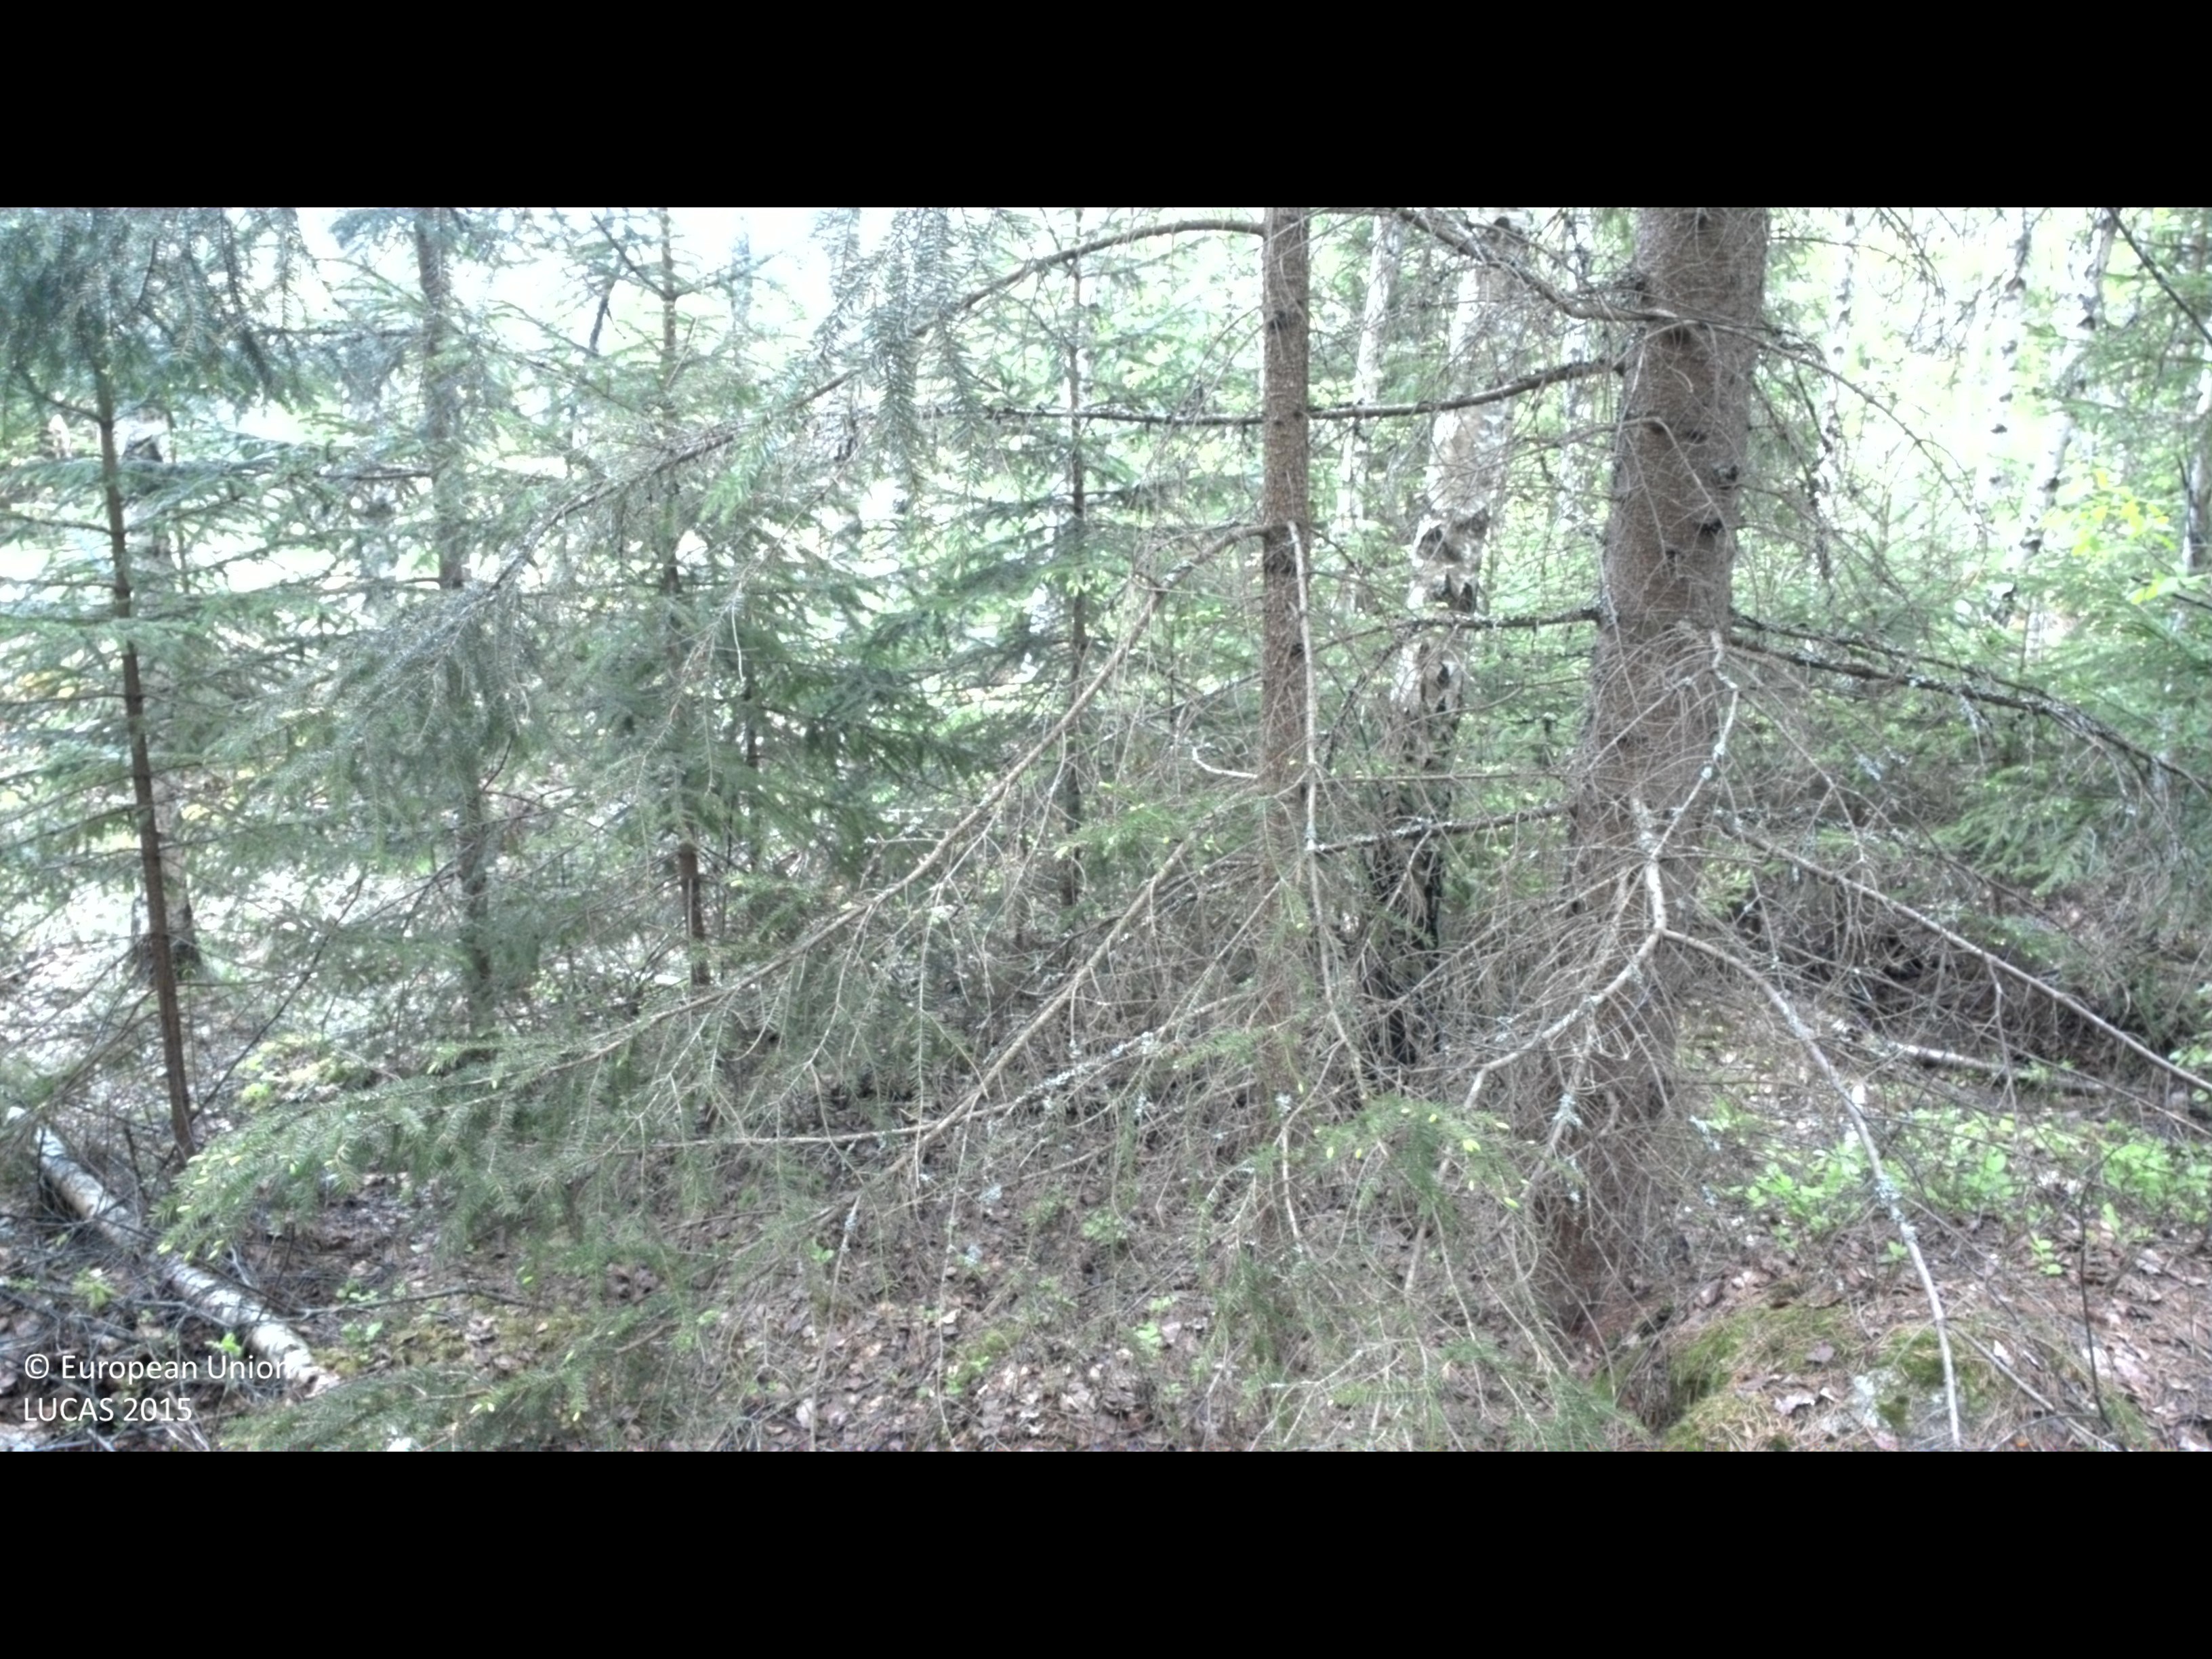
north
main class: Woodland
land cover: Pine dominated mixed woodland
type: boreal forest
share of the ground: > 75 %
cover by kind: coniferous forest trees 60 %, broadleaved forest trees 20 %, shrubs 10 %, lichens and mosses 10 %
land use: Forestry
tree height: > 5 m
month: May
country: SE
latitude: 57.3221
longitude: 16.1264
